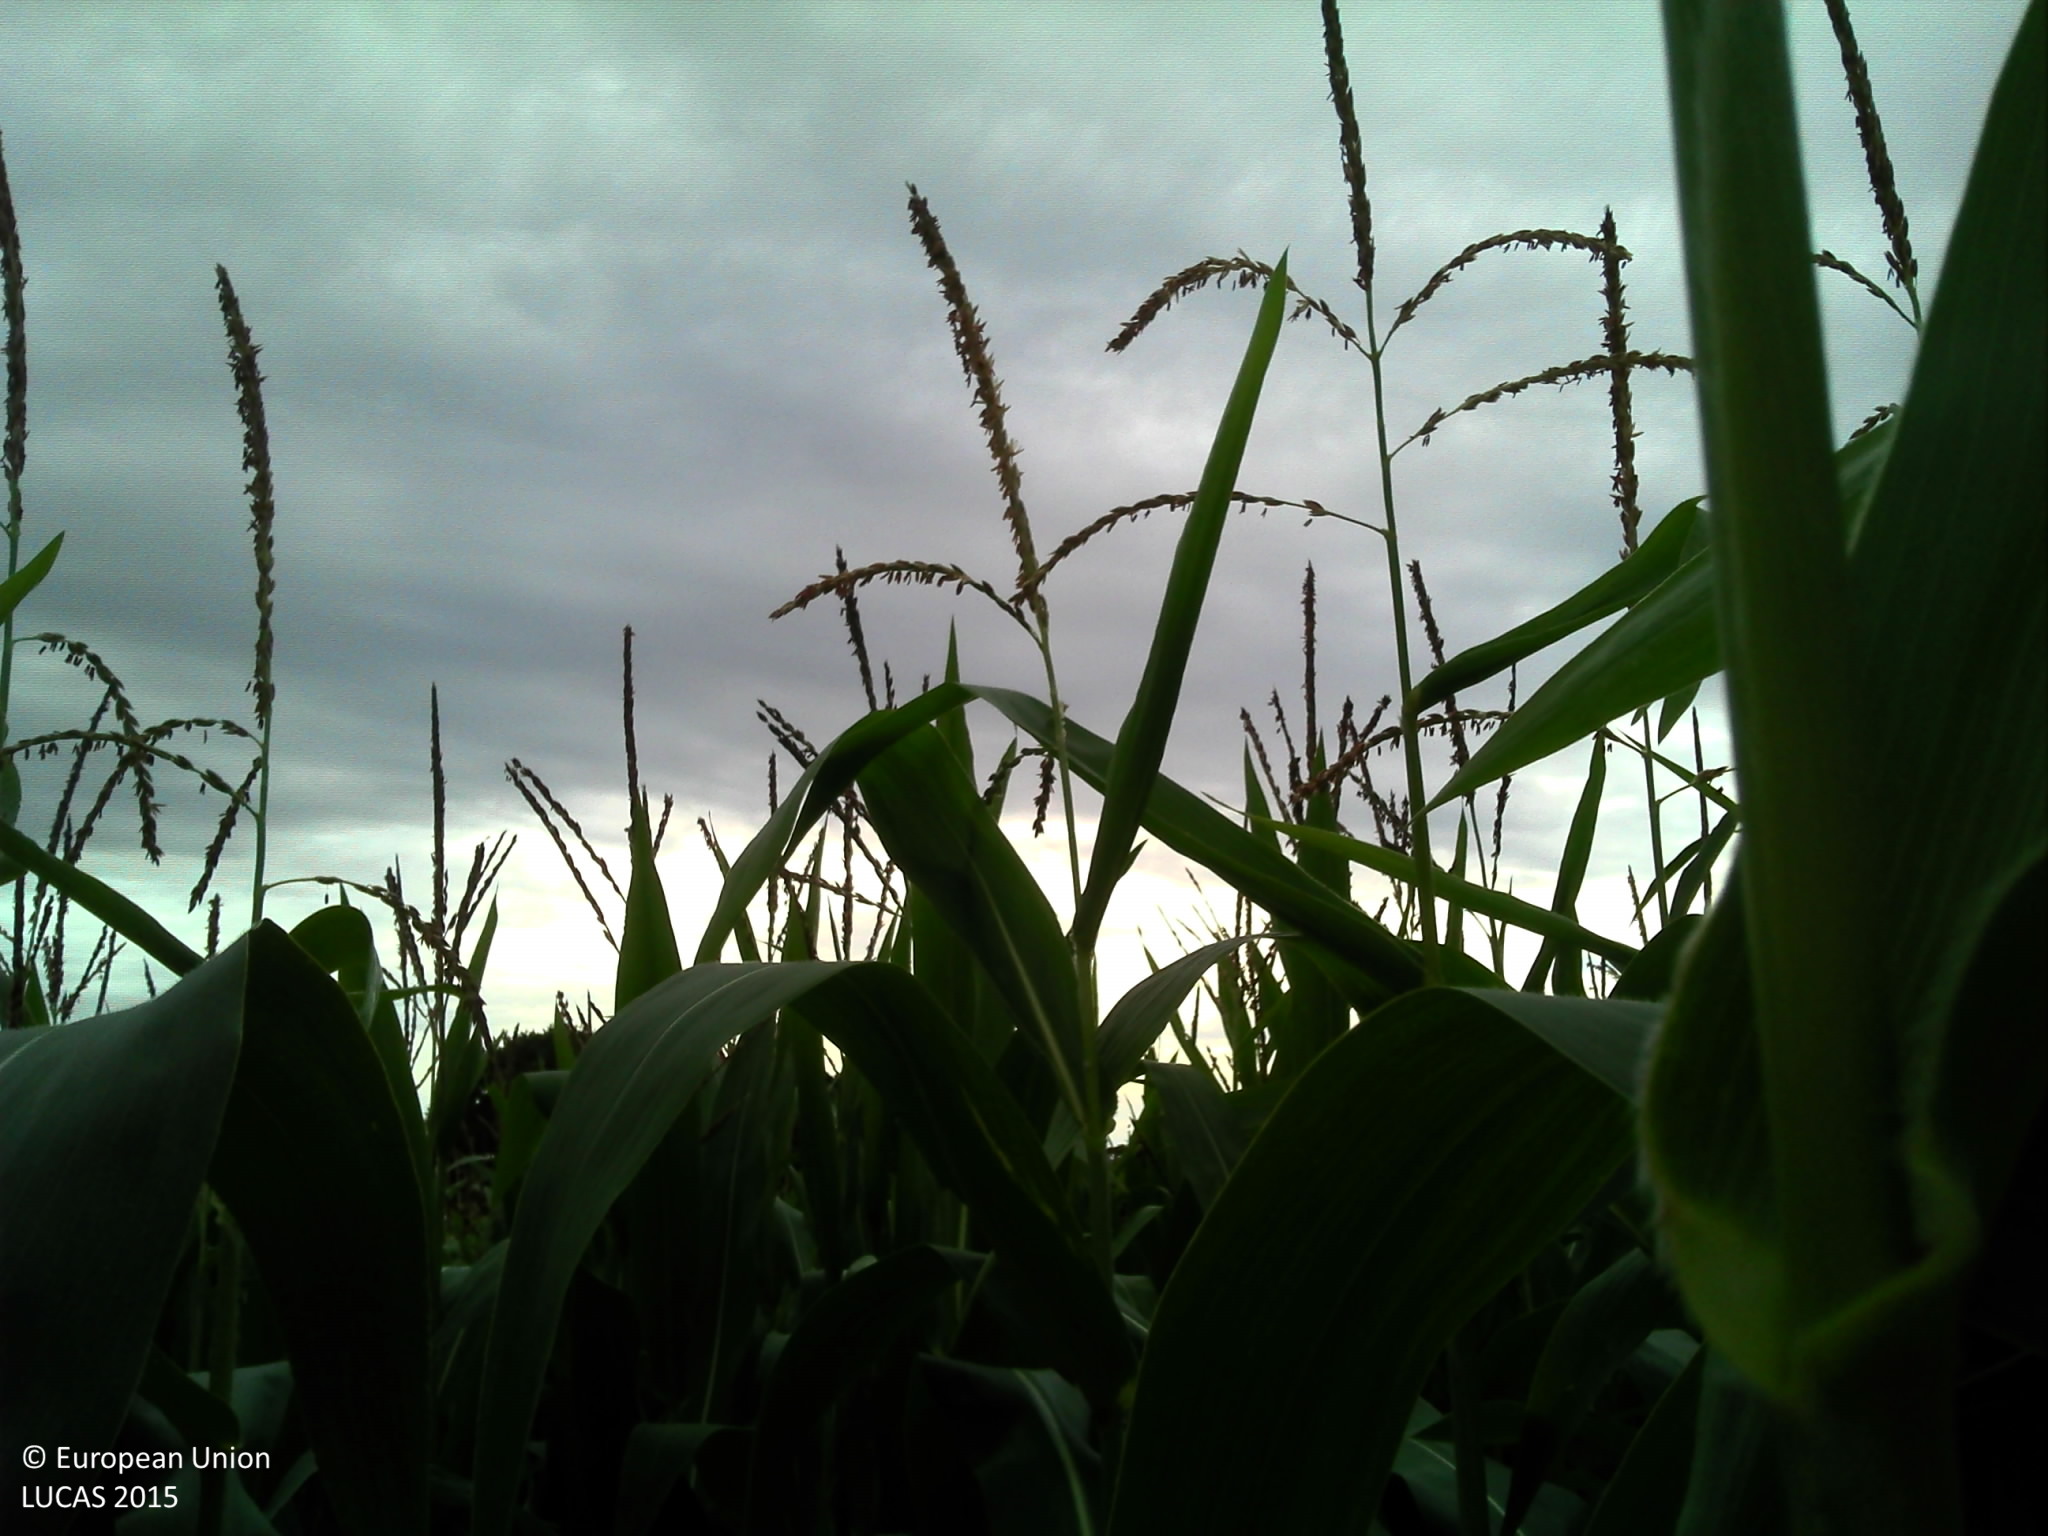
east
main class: Cropland
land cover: Maize
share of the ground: 50 - 75 %
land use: Agriculture (excluding fallow land and kitchen gardens)
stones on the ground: < 10 %
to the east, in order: Maize; Artificial constructions in urban areas; Grassland with sparse tree/shrub cover
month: August
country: FR
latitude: 48.2616
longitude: -3.3711
